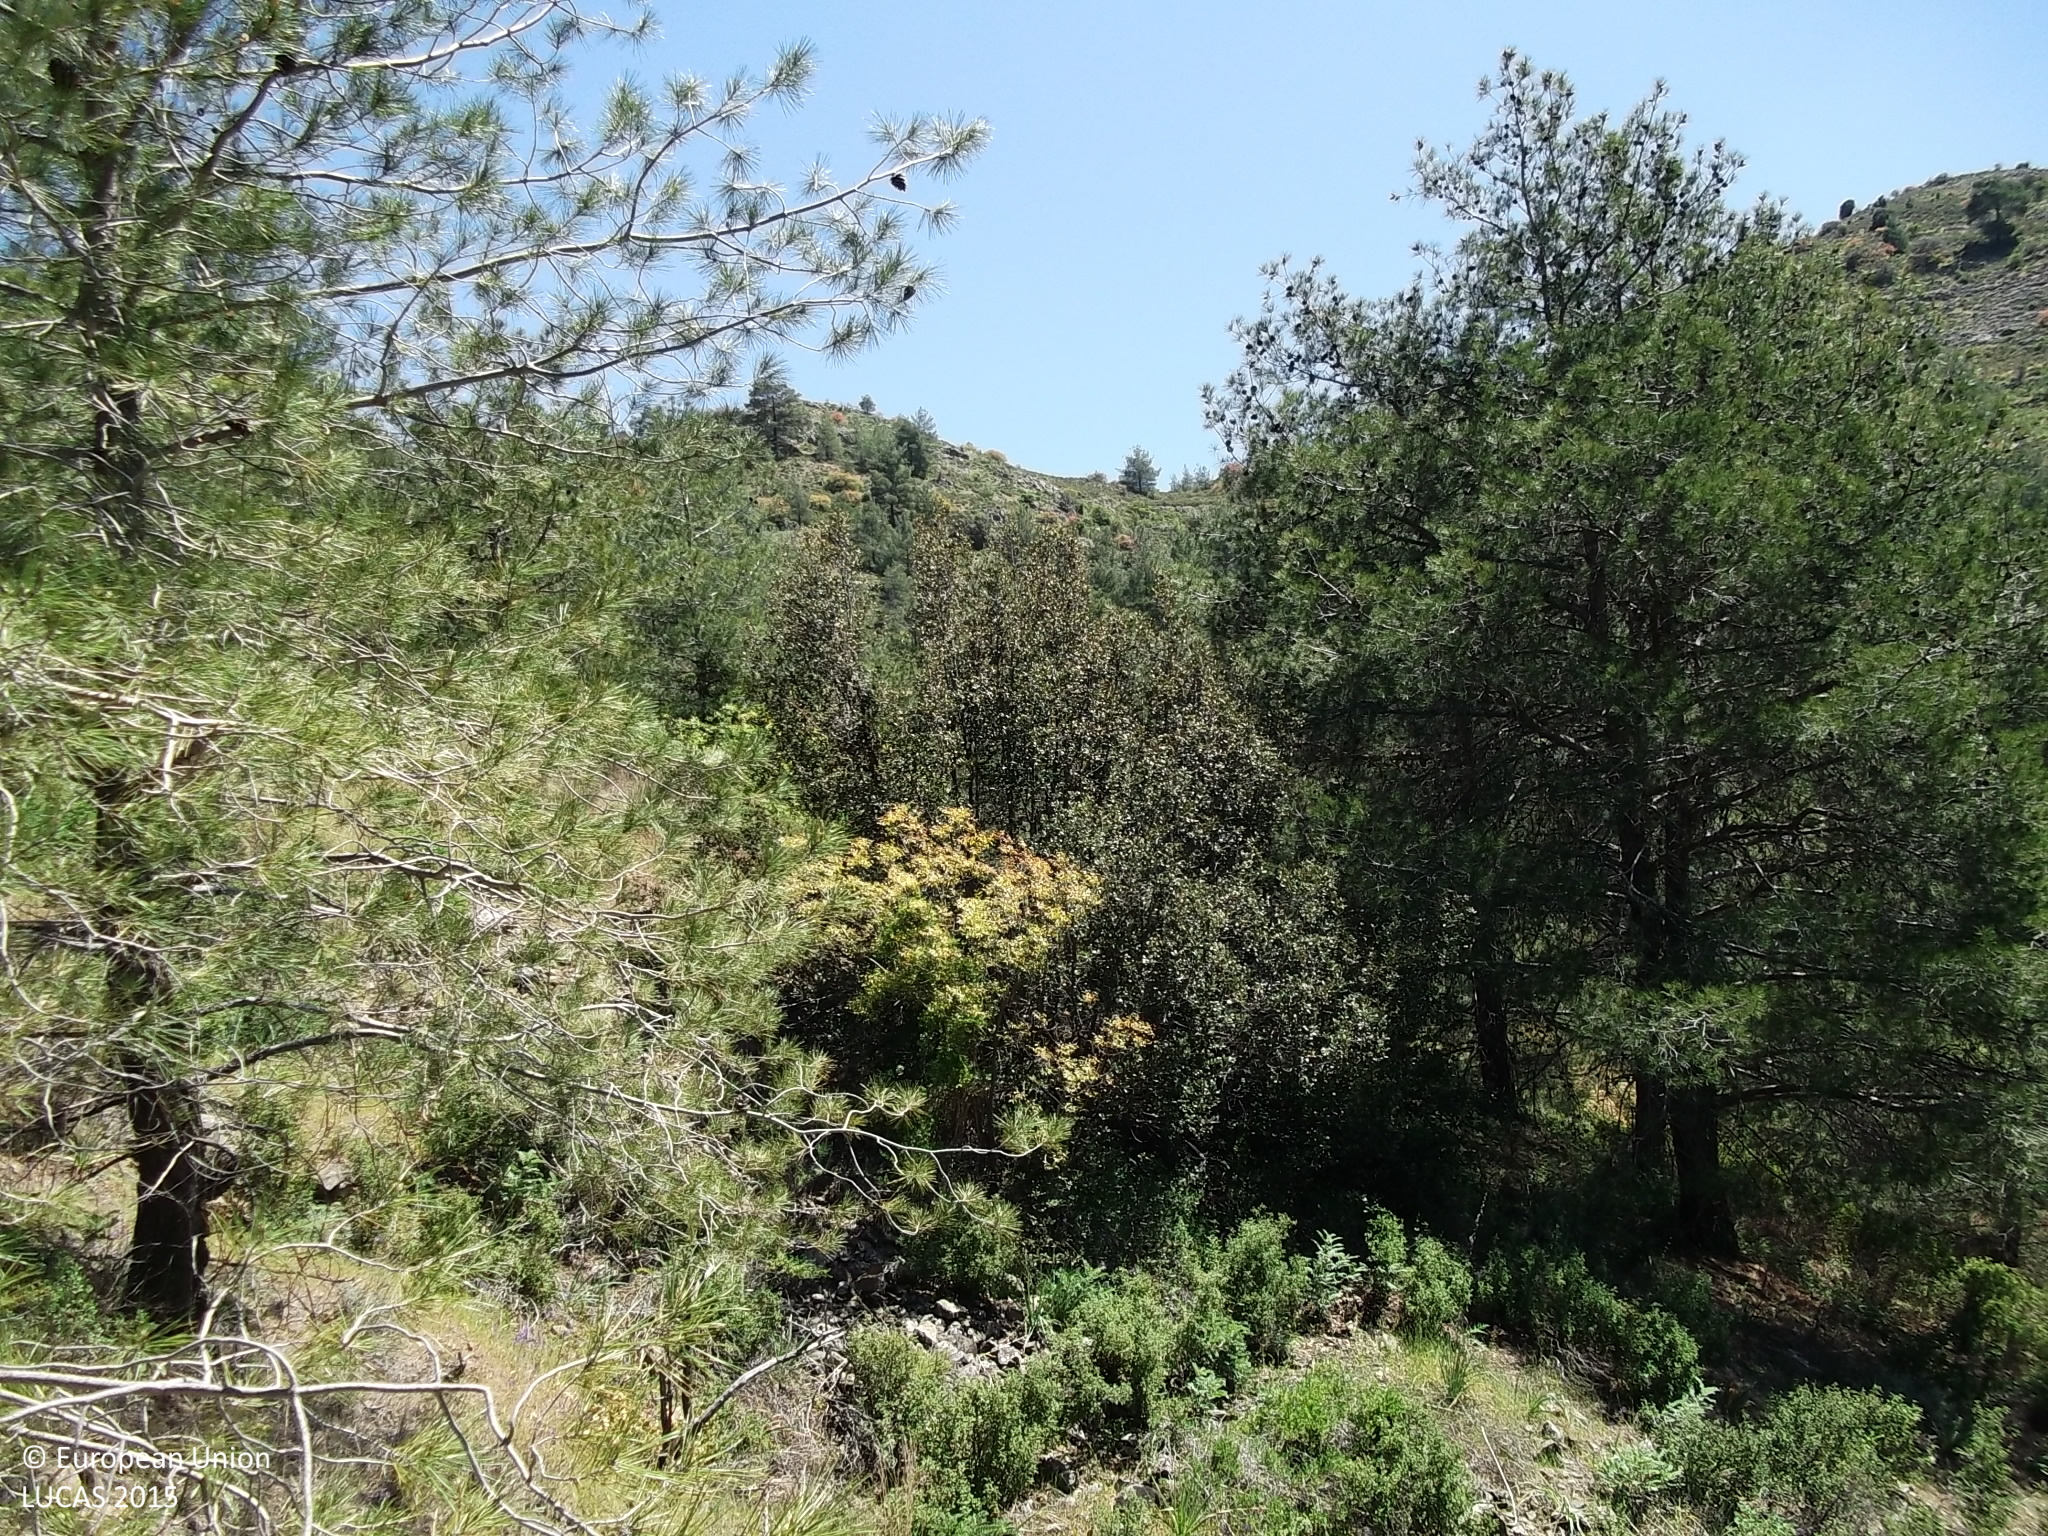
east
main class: Woodland
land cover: Pine dominated coniferous woodland
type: coniferous forest of the mediterranean region
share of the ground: 50 - 75 %
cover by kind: coniferous forest trees 70 %, shrubs 20 %, unconsolidated bare surface 10 %
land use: Semi-natural and natural areas not in use
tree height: > 5 m
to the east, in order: Pine dominated coniferous woodland
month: April
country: CY
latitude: 34.9406
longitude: 33.1598
